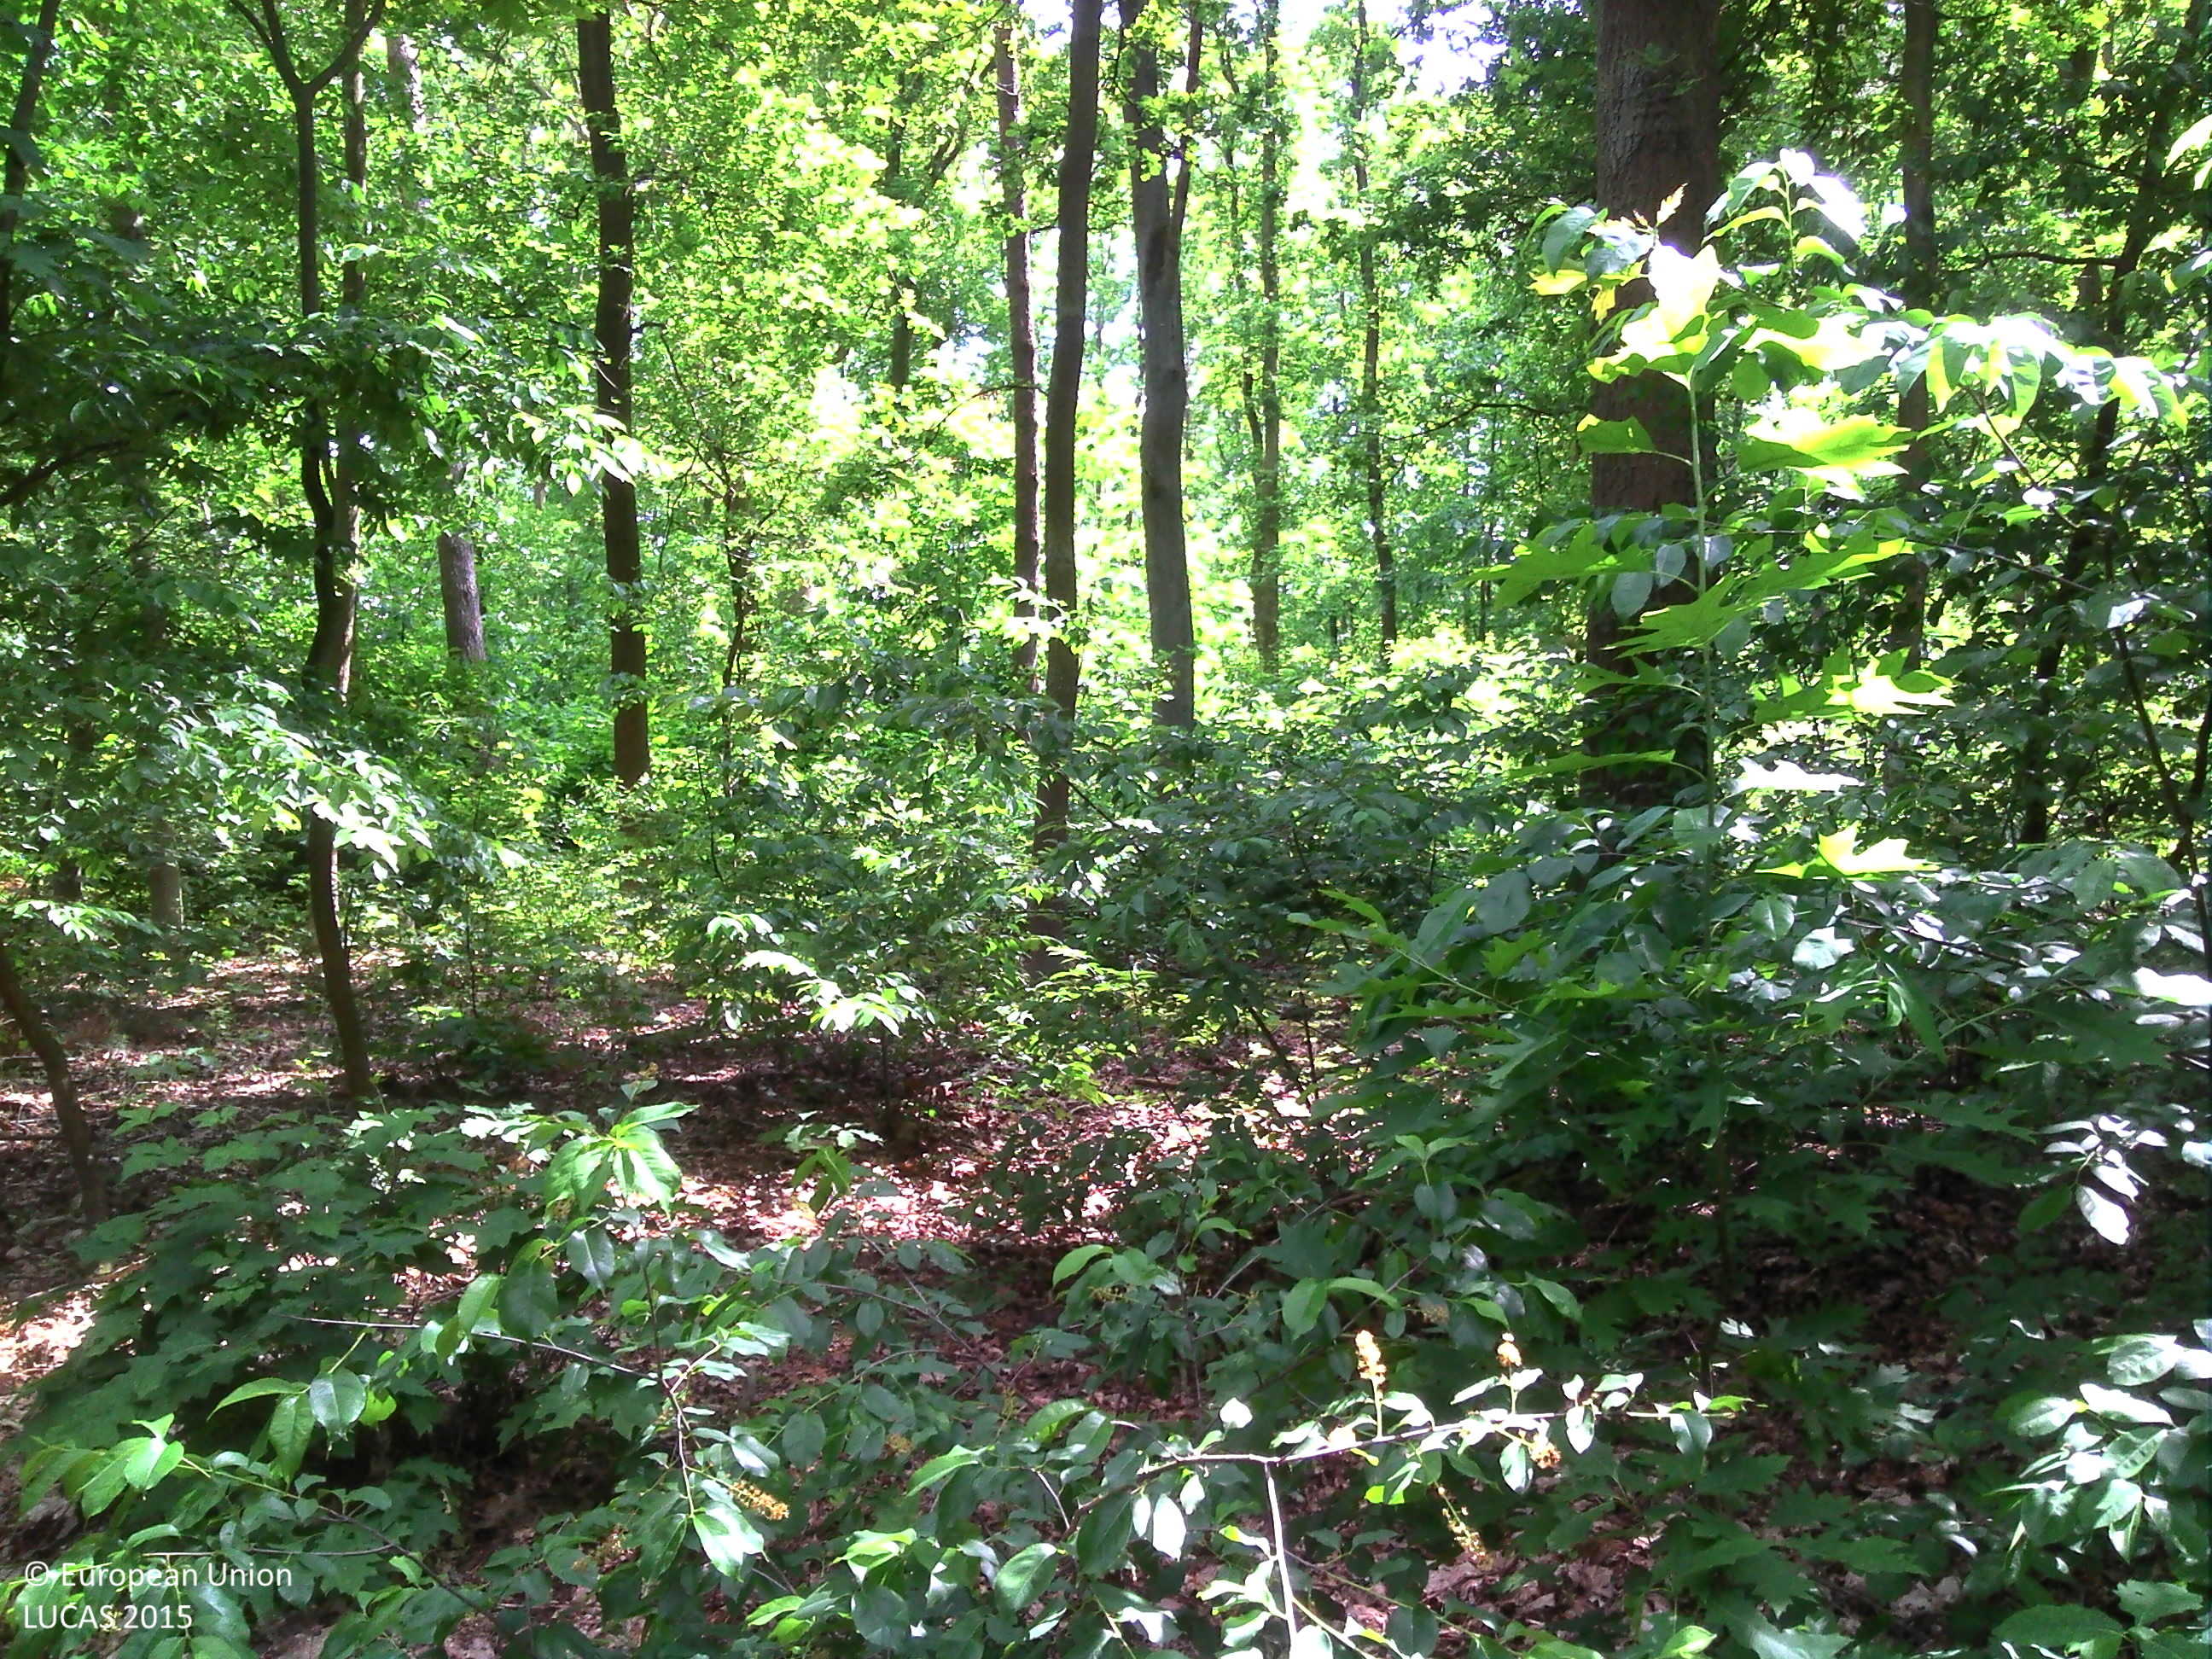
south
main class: Woodland
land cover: Pine dominated mixed woodland
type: exotic forest
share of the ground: > 75 %
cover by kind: broadleaved forest trees 70 %, coniferous forest trees 25 %, herbaceous plants 5 %
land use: Forestry
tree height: > 5 m
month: June
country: BE
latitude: 51.0756
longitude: 5.7023
